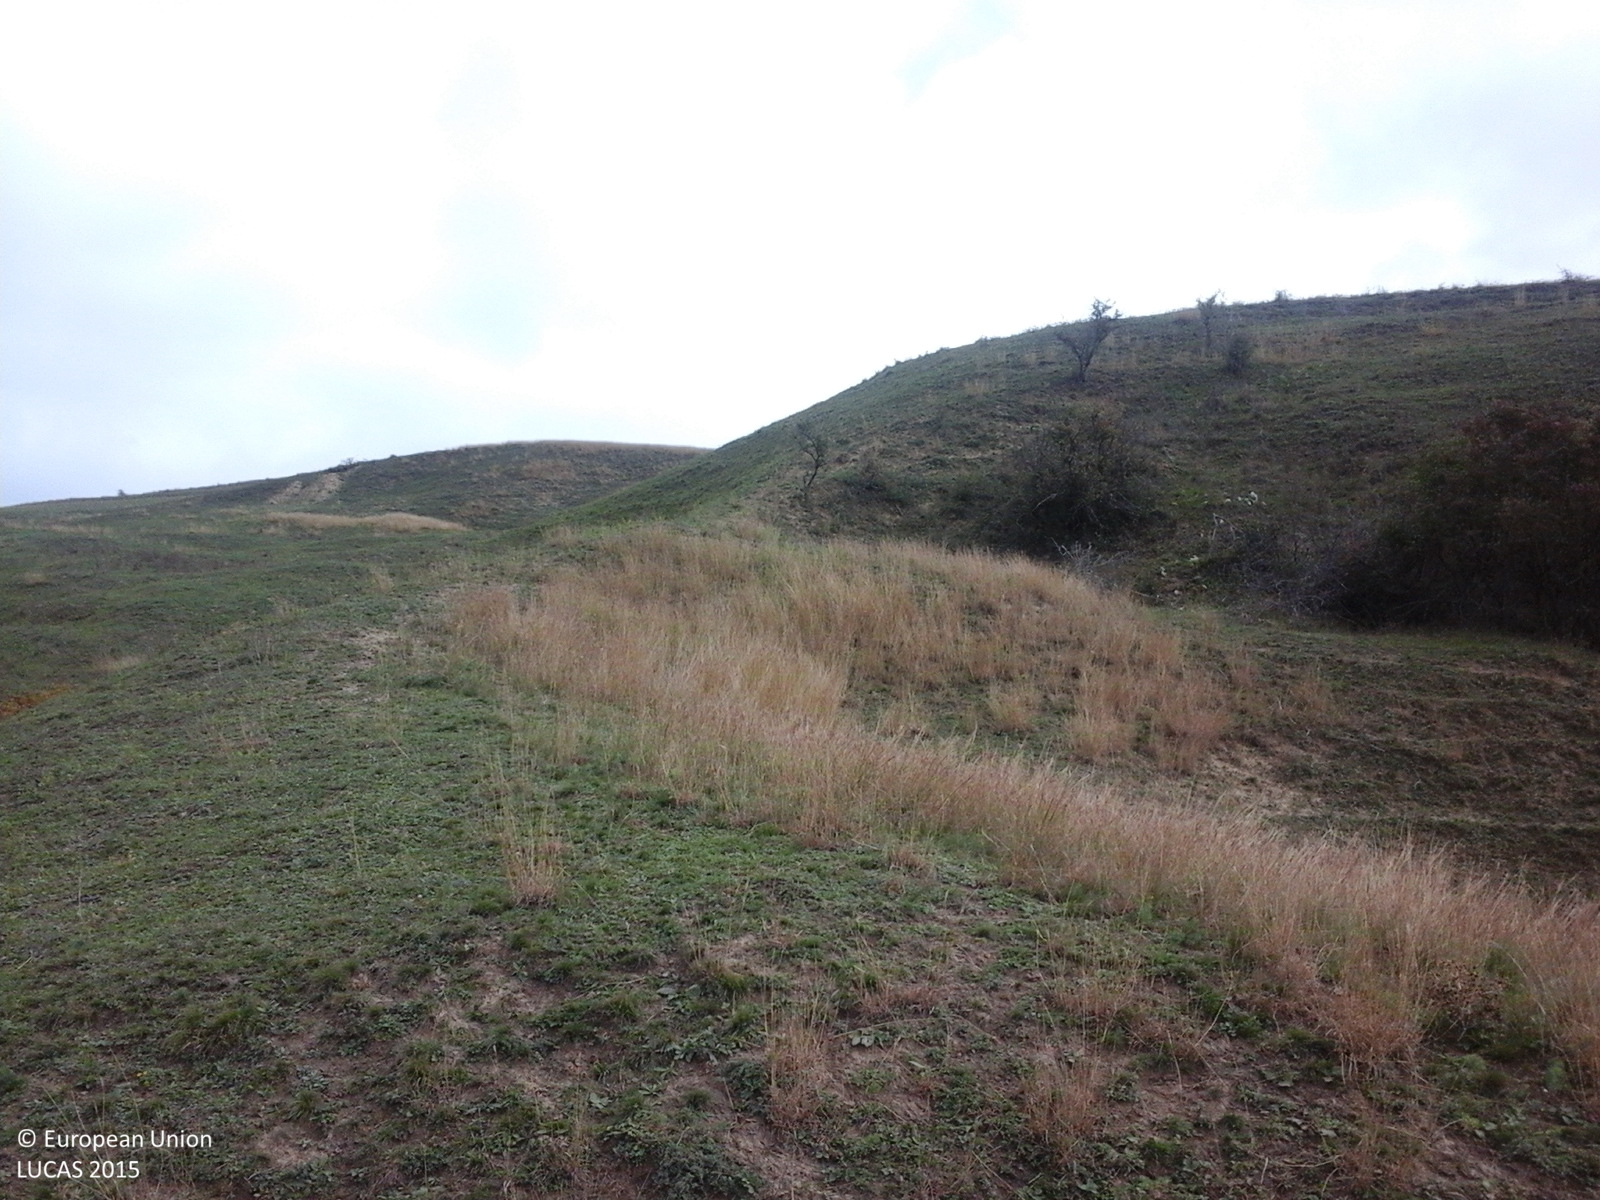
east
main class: Grassland
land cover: Grassland without tree/shrub cover
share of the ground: > 75 %
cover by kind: herbaceous plants 100 %
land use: Agriculture (excluding fallow land and kitchen gardens)
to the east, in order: Grassland without tree/shrub cover
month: October
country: RO
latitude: 46.4245
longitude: 24.0393
